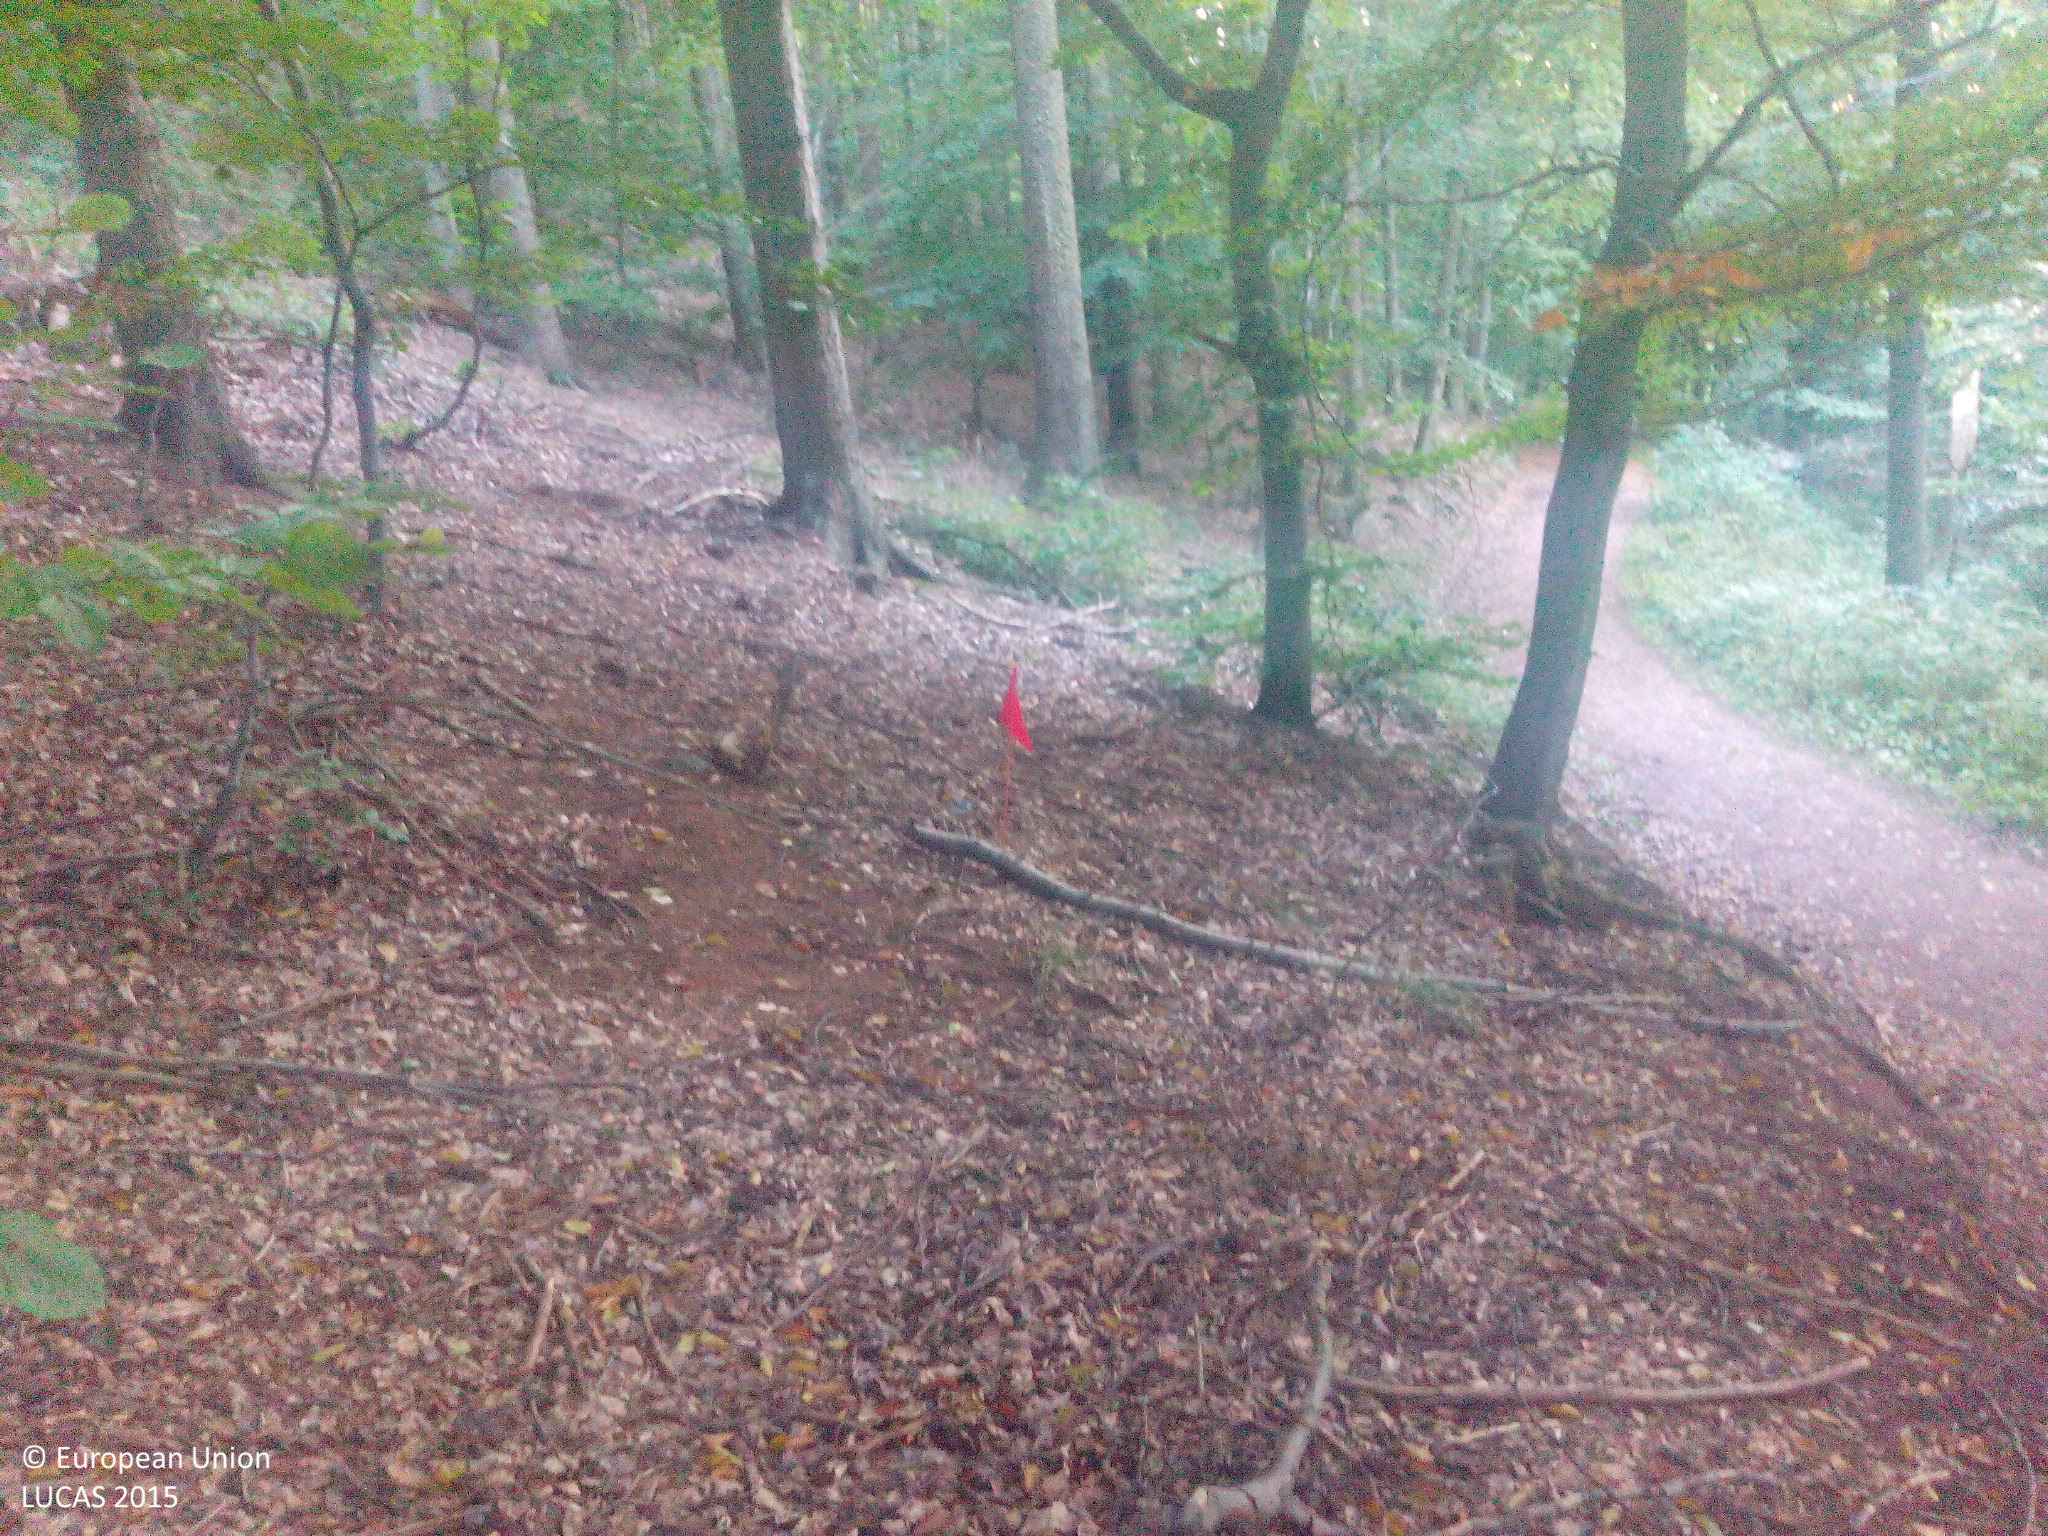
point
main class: Woodland
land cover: Spruce dominated mixed woodland
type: hemiboreal forest and nemoral coniferous forest and mixed broadleaved-coniferous forest
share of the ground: > 75 %
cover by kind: coniferous forest trees 50 %, broadleaved forest trees 50 %
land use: Forestry
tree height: > 5 m
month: September
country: DE
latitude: 51.4198
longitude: 11.0782
